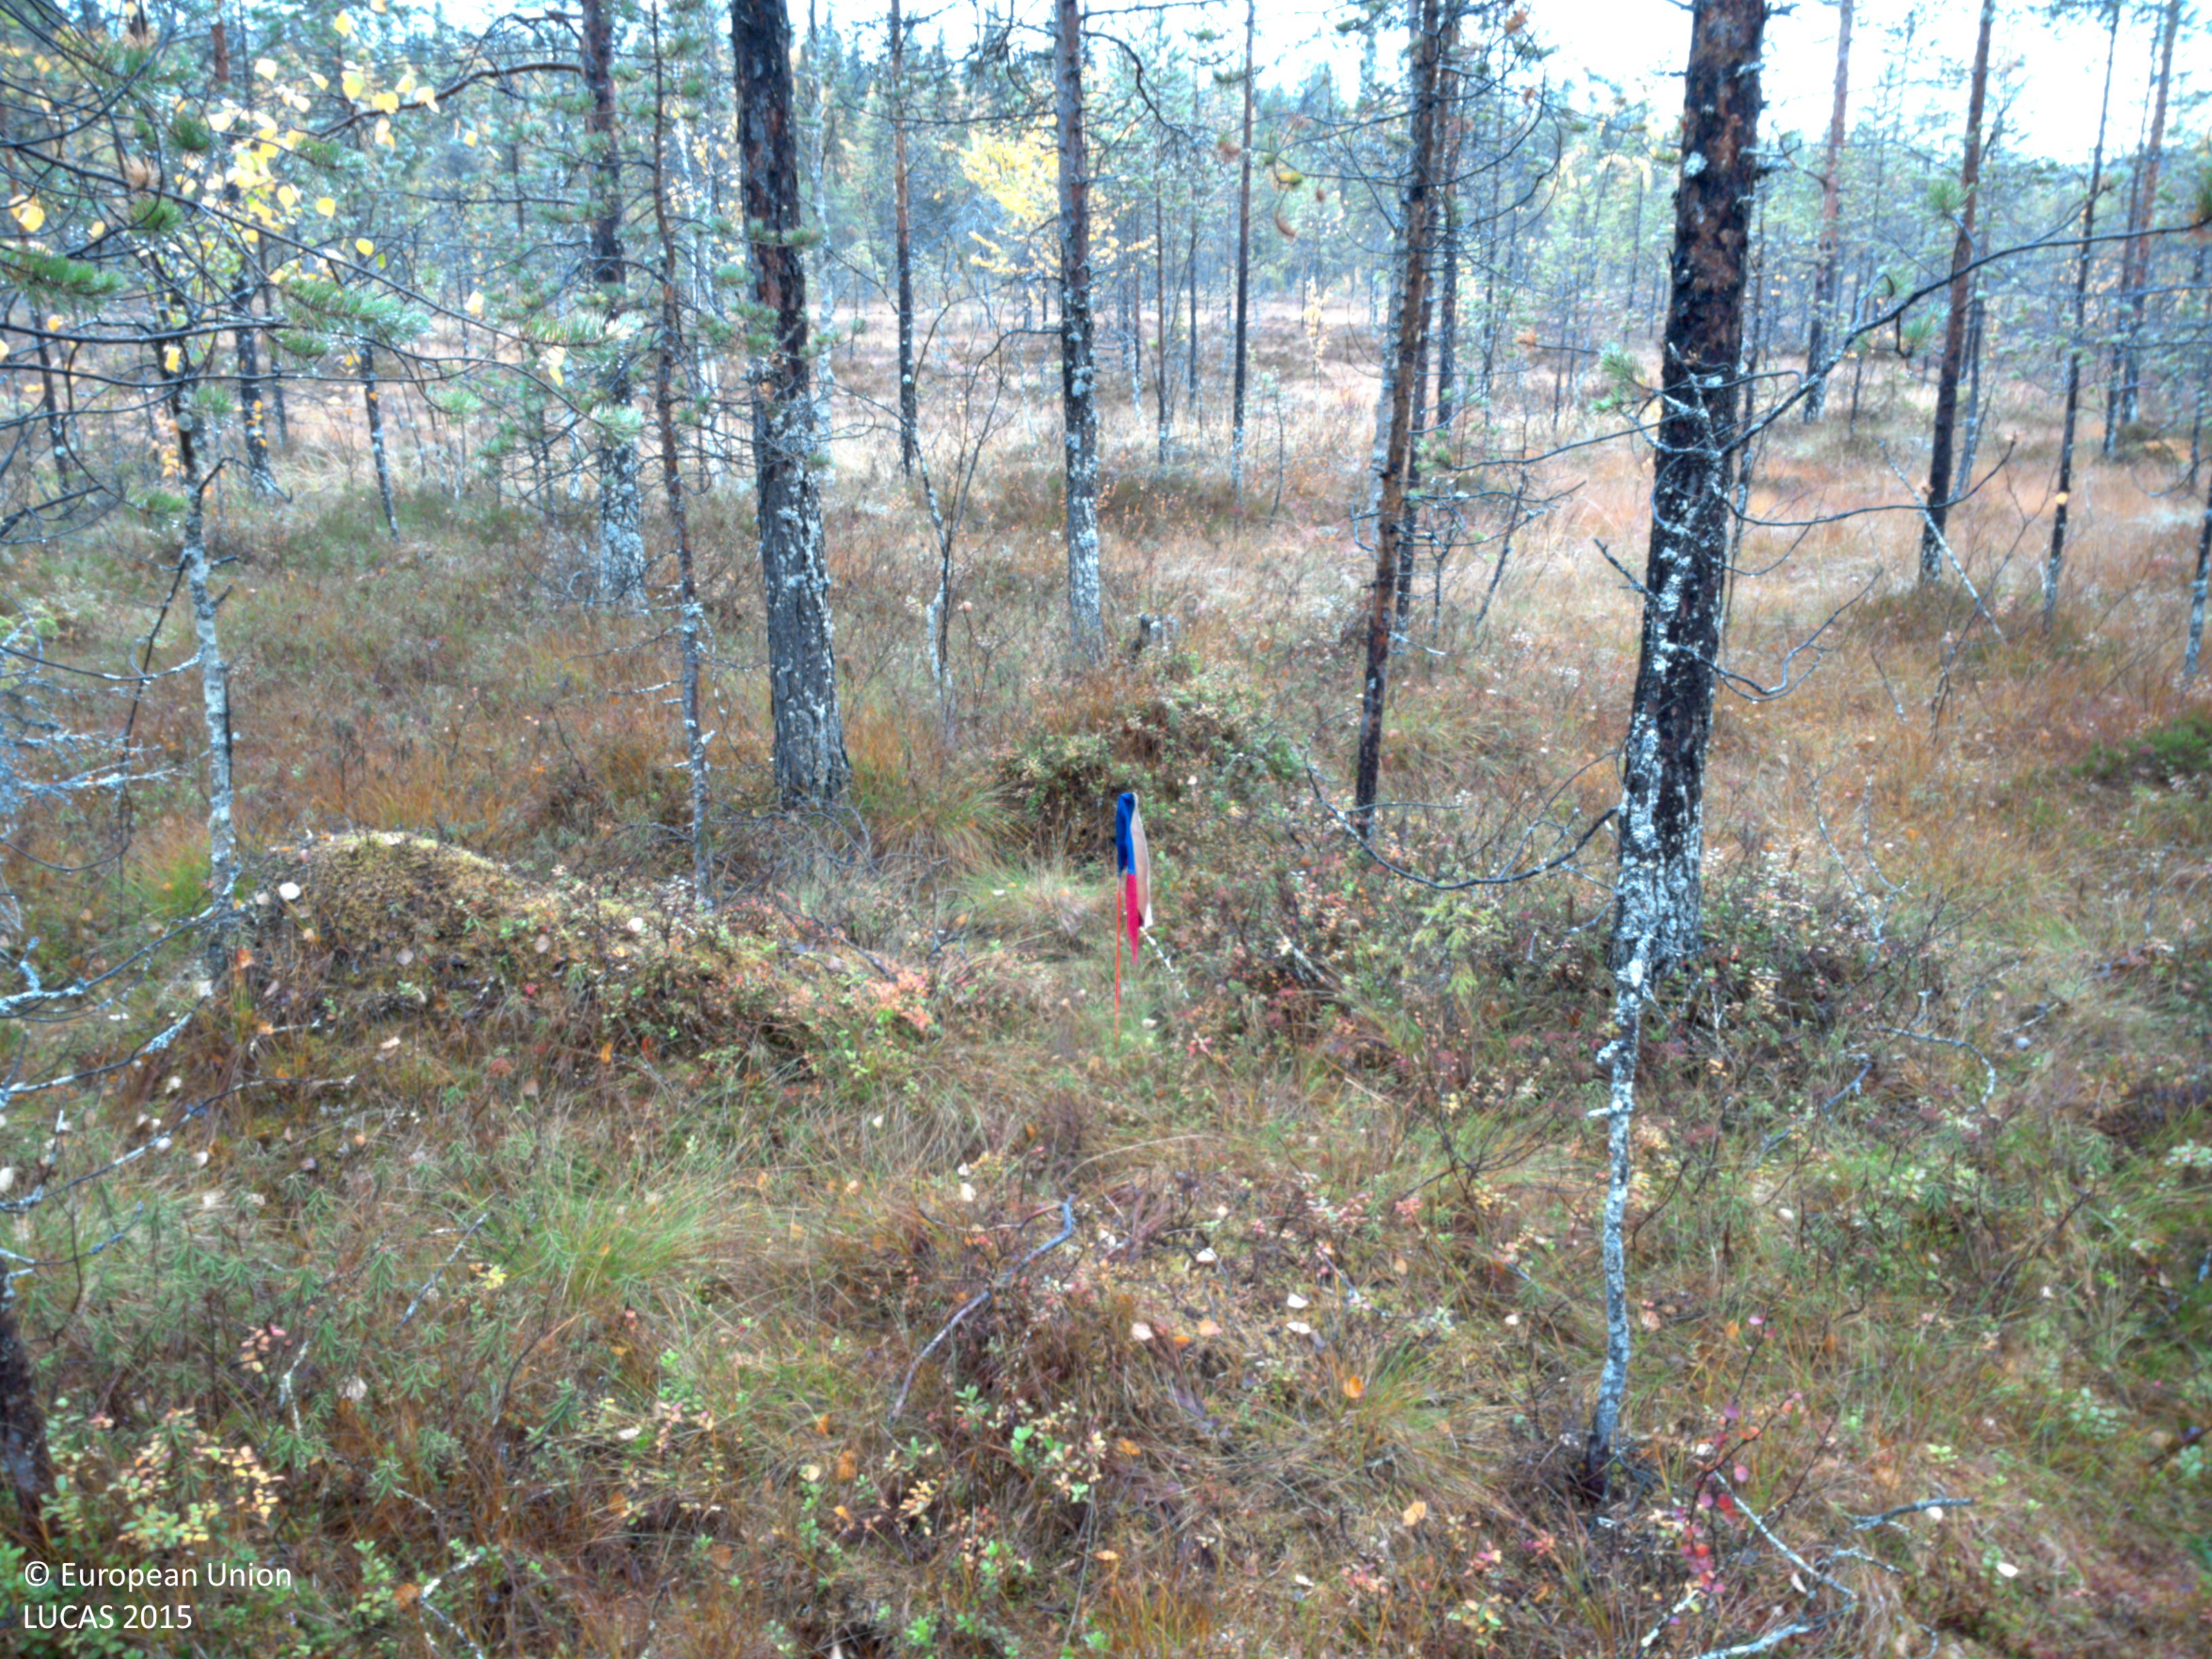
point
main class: Woodland
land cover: Pine dominated coniferous woodland
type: mire and swamp forests
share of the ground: 25 - 50 %
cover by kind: shrubs 35 %, coniferous forest trees 25 %, herbaceous plants 20 %, lichens and mosses 15 %, broadleaved forest trees 5 %
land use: Forestry
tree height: > 5 m
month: September
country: SE
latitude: 64.9718
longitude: 19.1389
